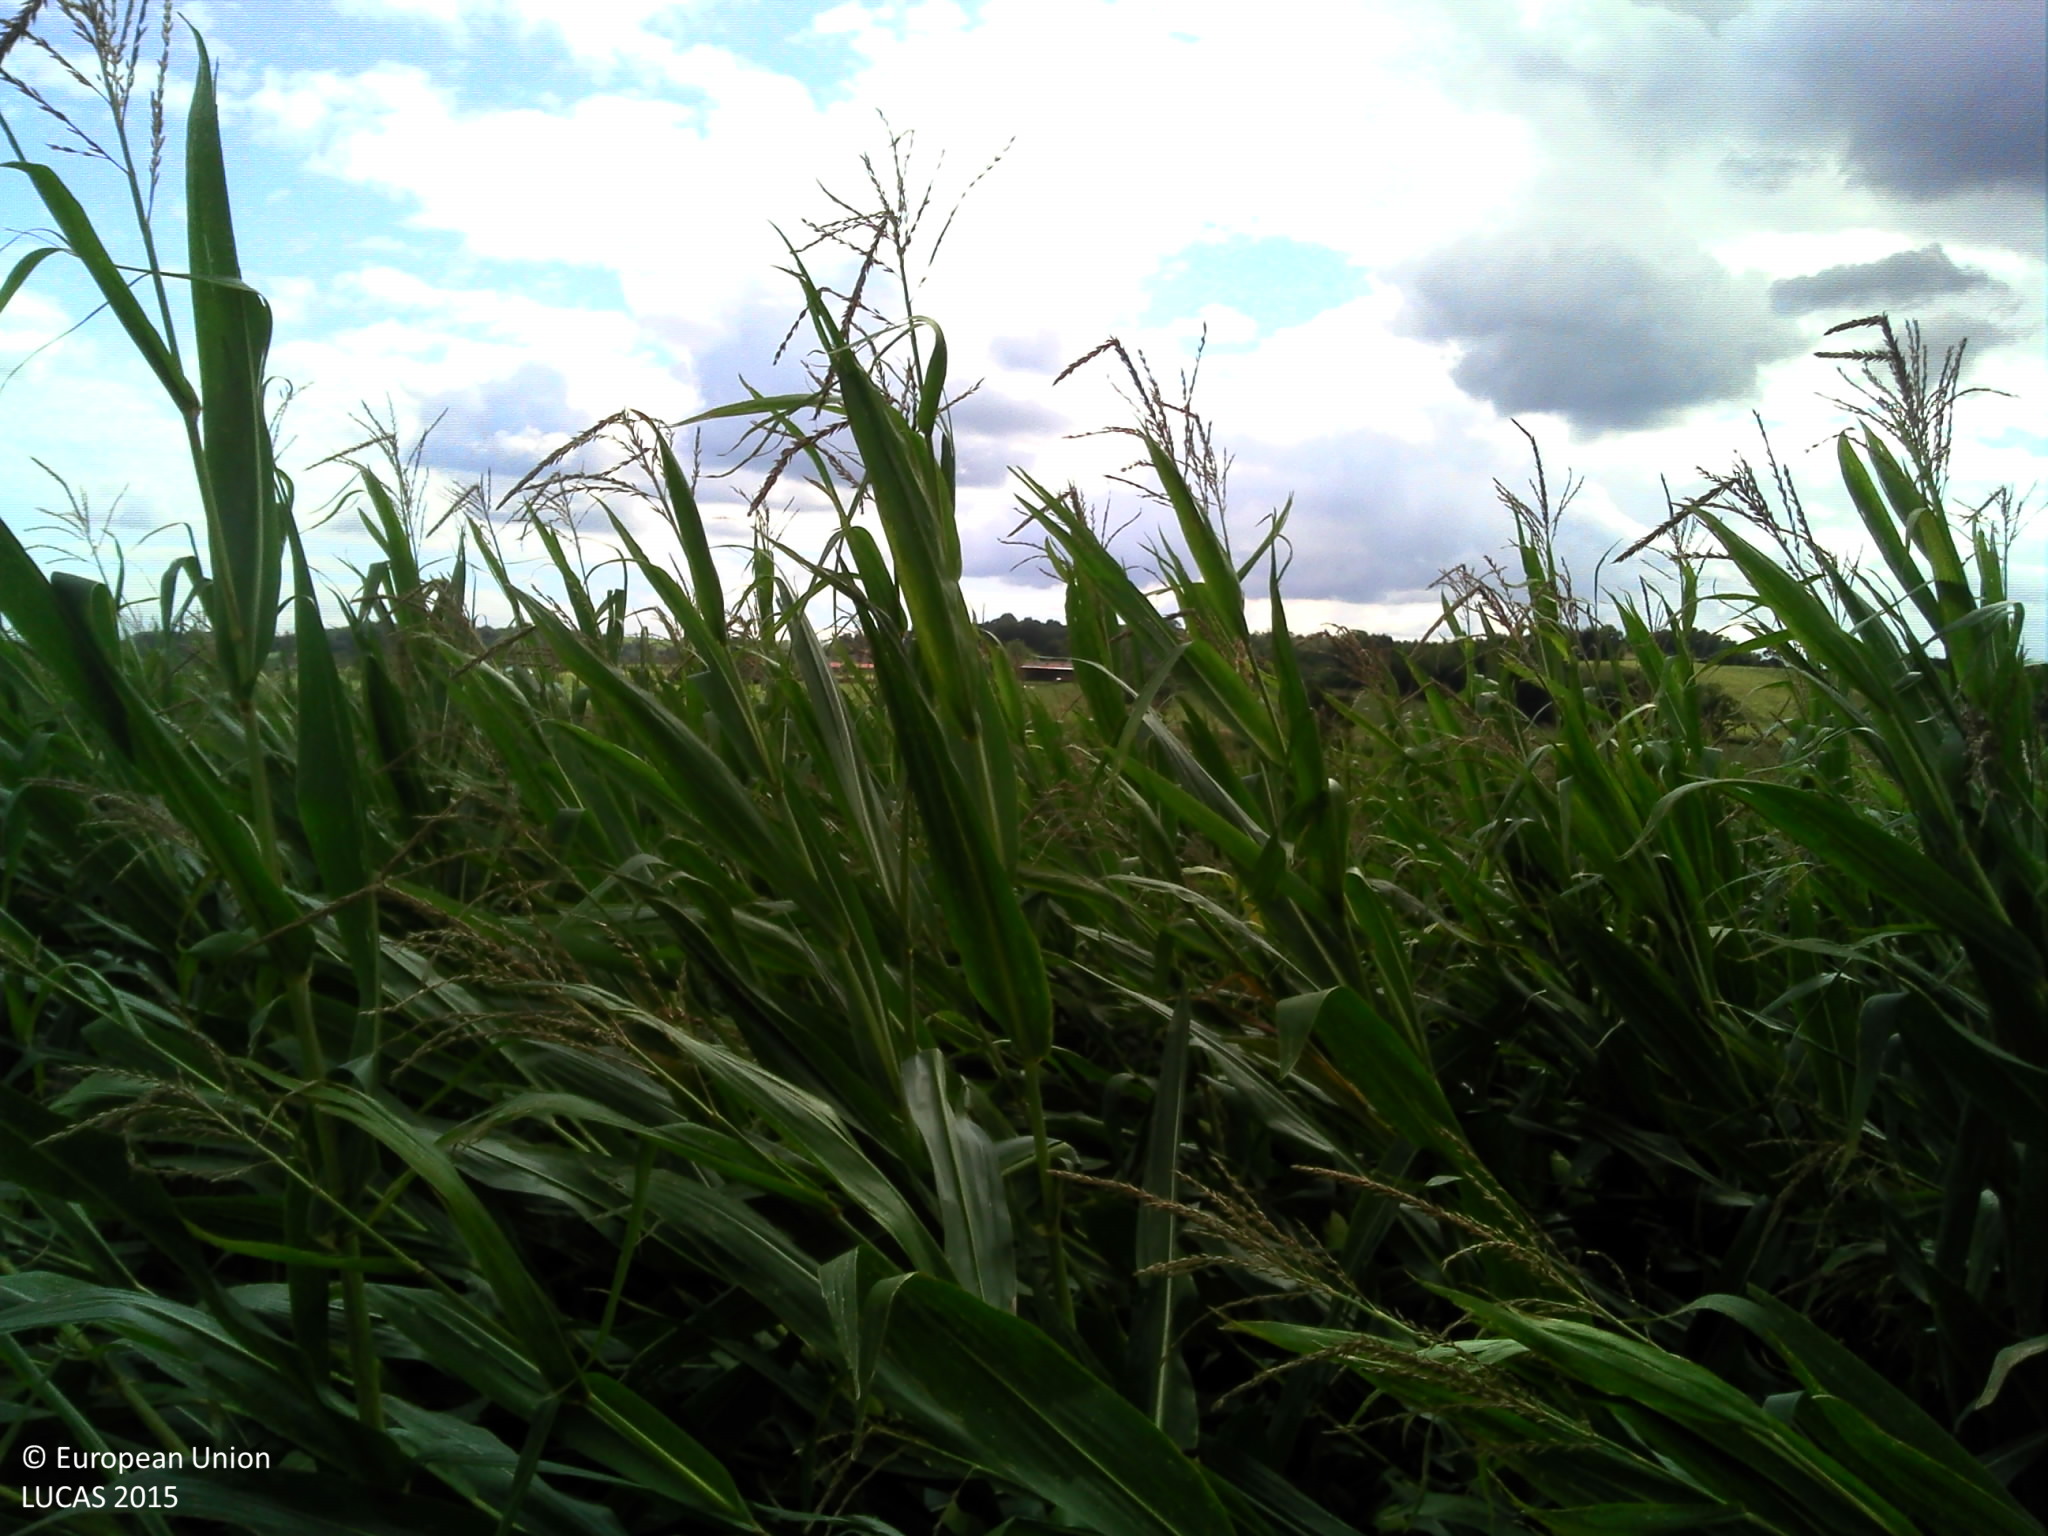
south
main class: Cropland
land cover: Maize
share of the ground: > 75 %
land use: Agriculture (excluding fallow land and kitchen gardens)
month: September
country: FR
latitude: 43.5138
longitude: -0.4370
